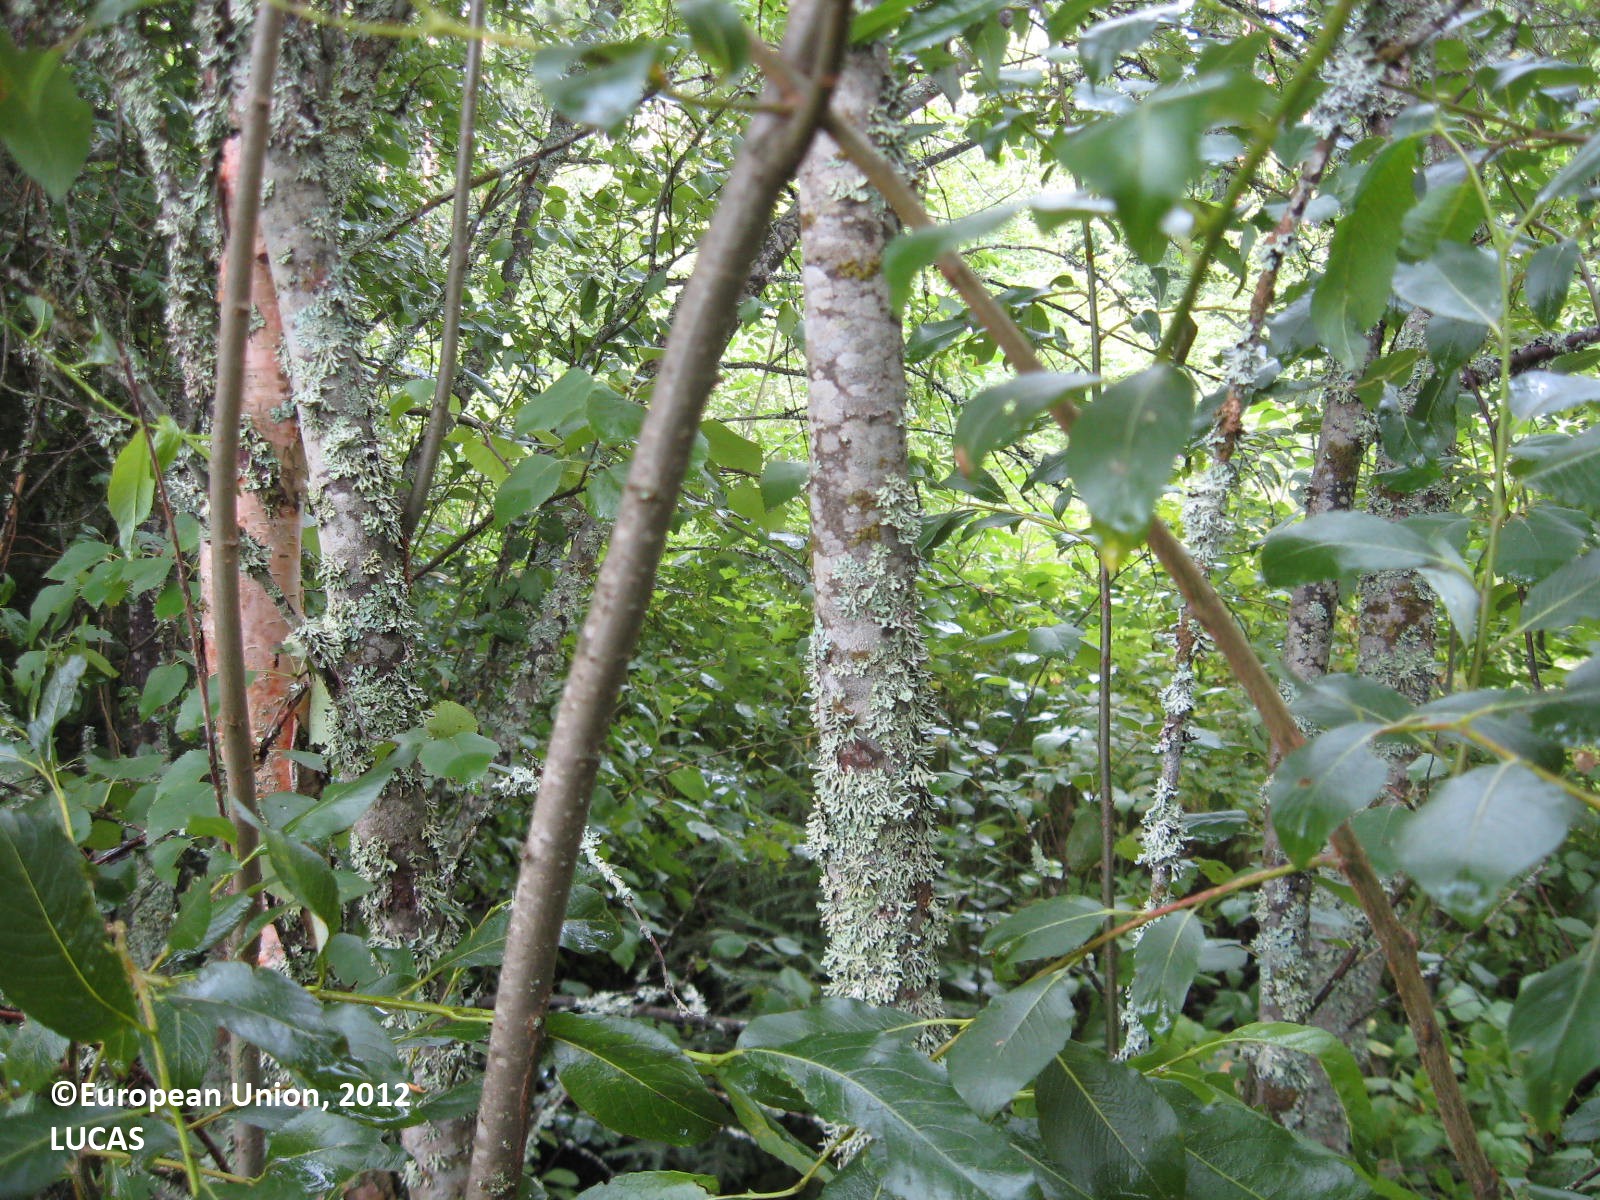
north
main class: Woodland
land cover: Broadleaved woodland
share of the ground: > 75 %
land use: Forestry
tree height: > 5 m
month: July
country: FI
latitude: 62.0870
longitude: 22.5249
